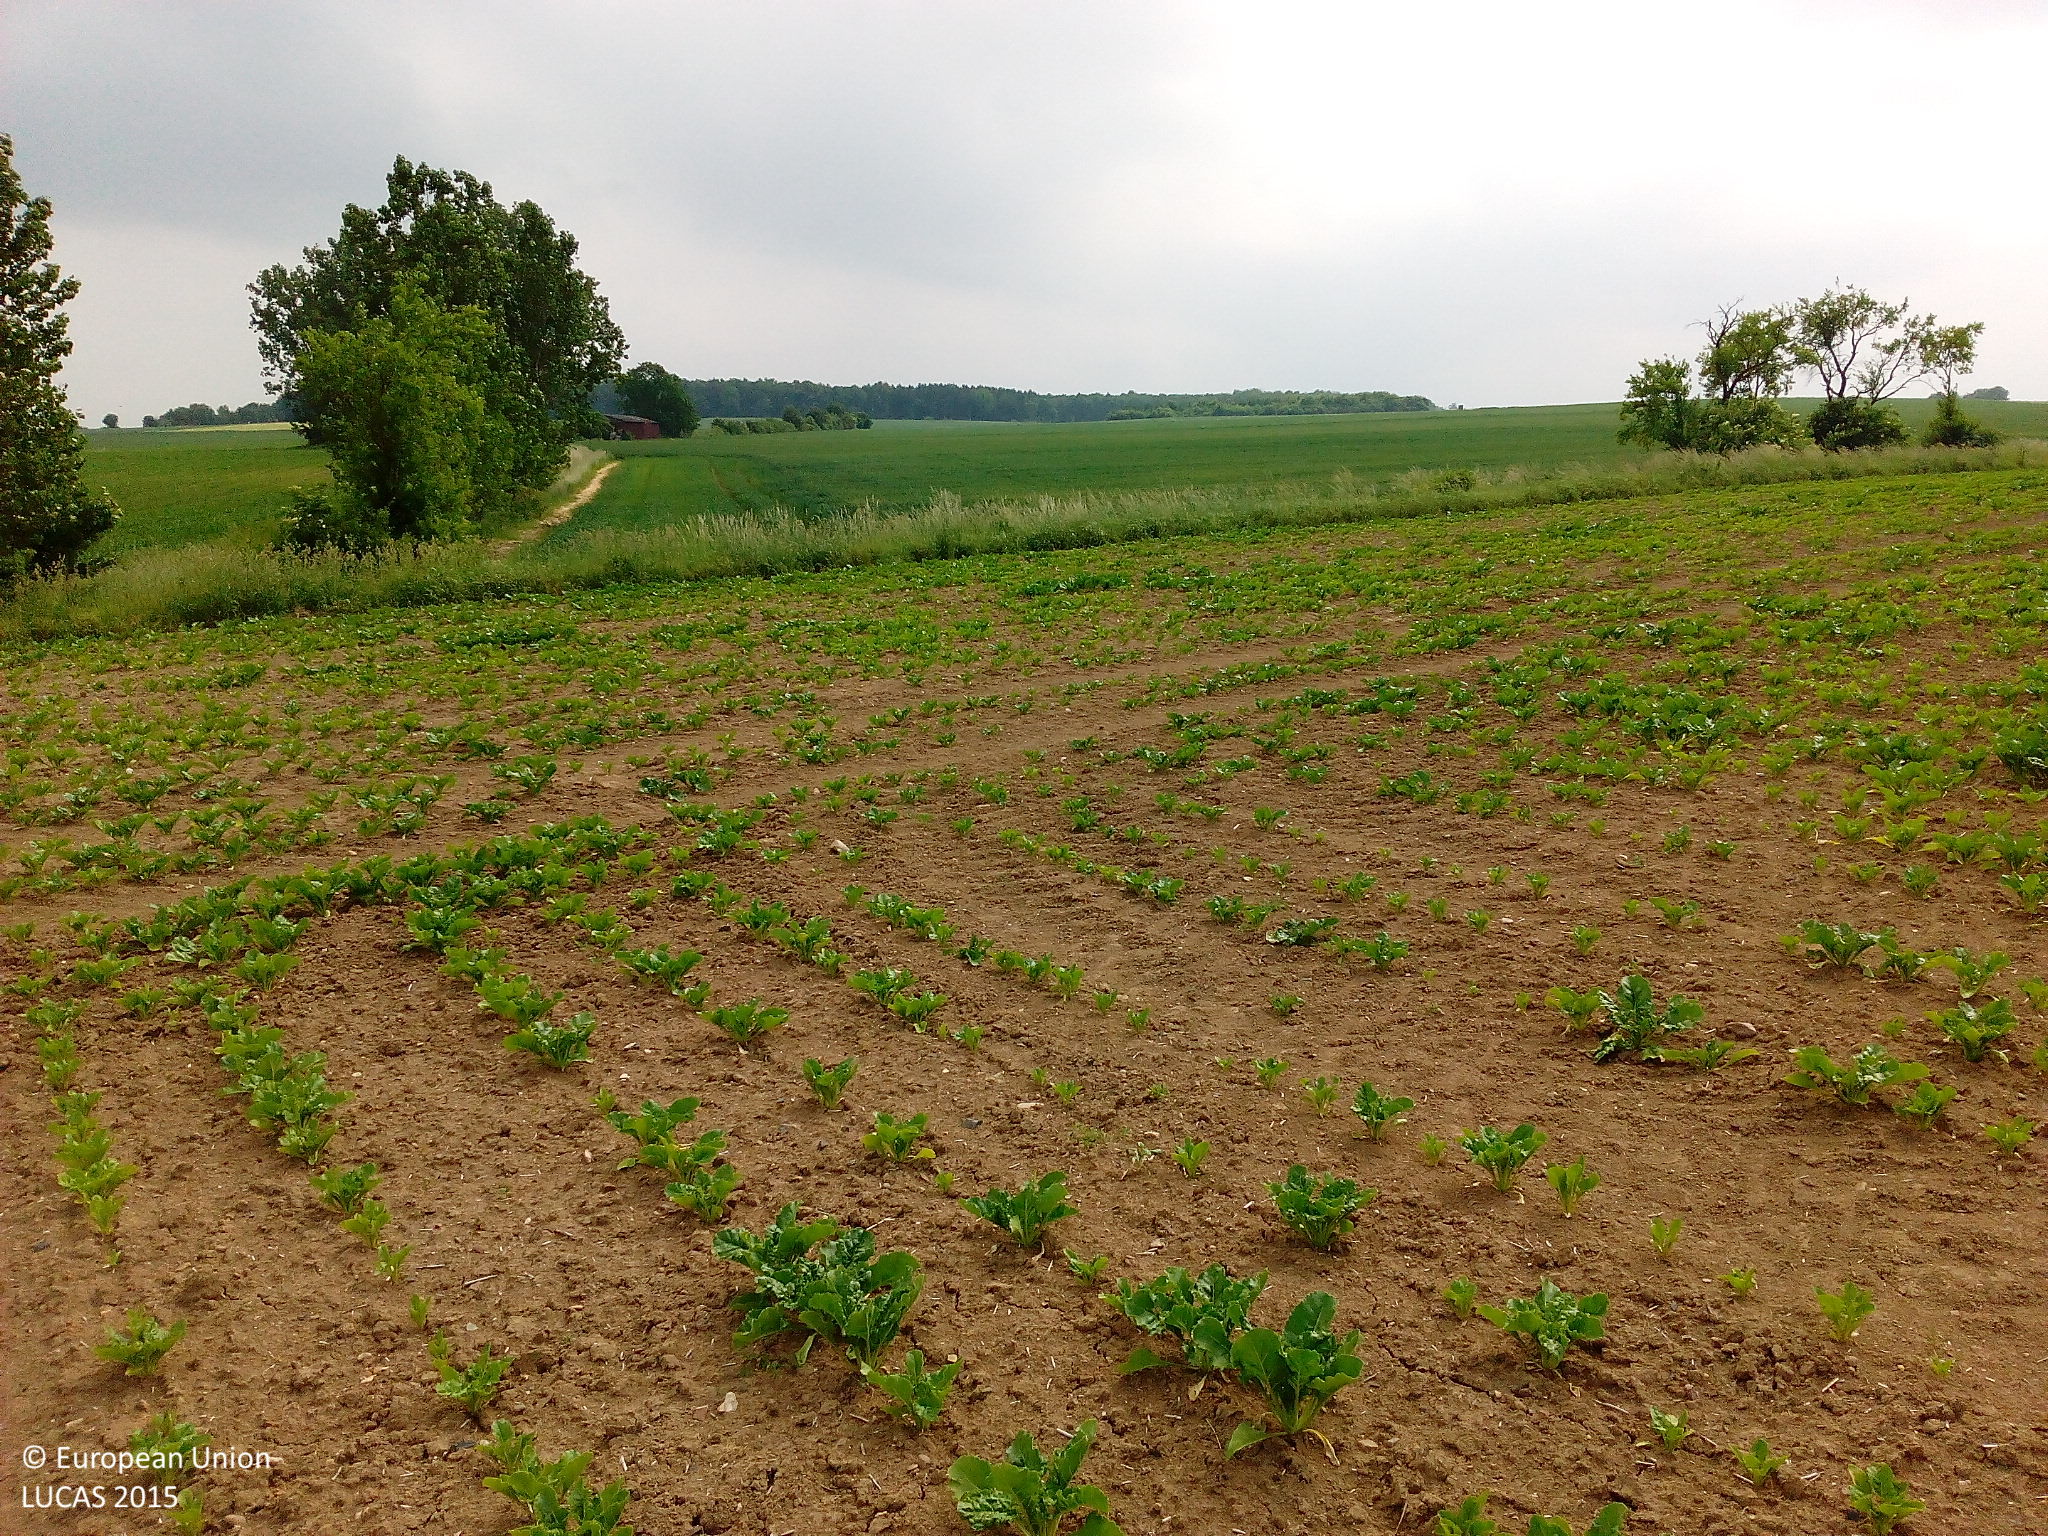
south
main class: Cropland
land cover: Sugar beet
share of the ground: 25 - 50 %
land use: Agriculture (excluding fallow land and kitchen gardens)
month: June
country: DE
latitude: 51.1534
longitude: 9.3568
